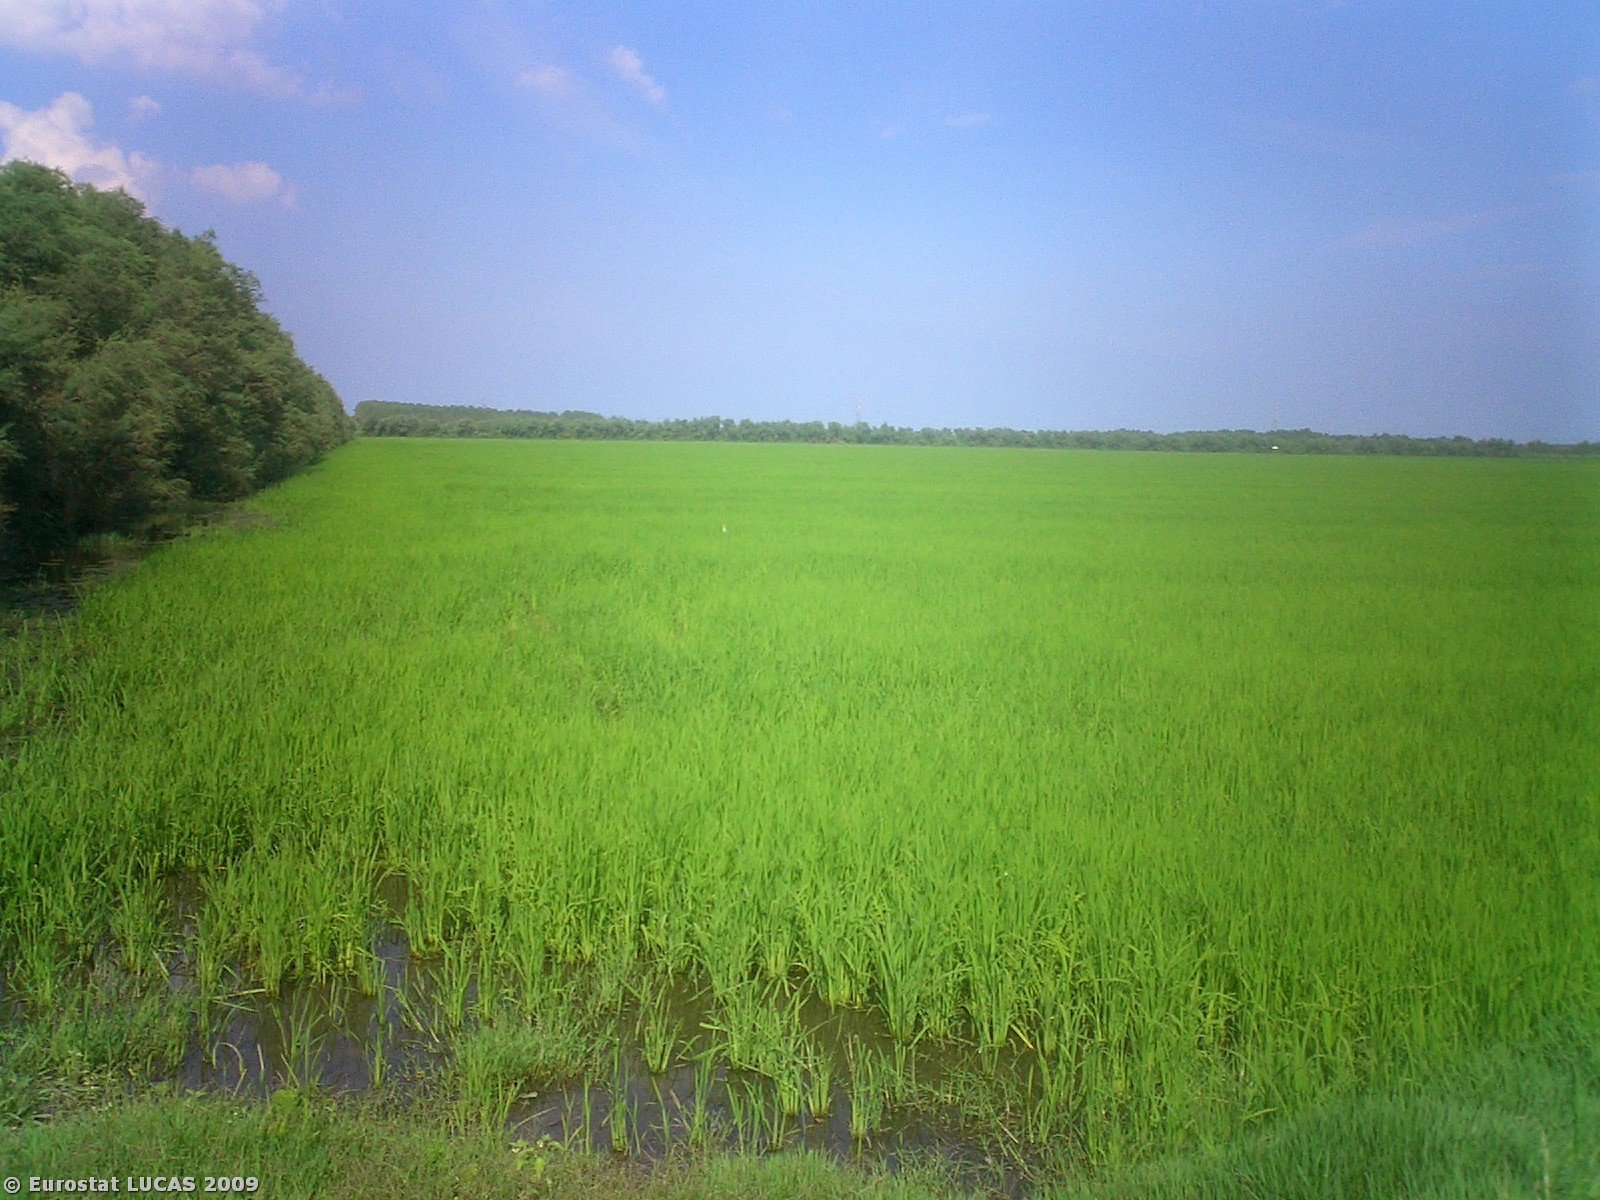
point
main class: Cropland
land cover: Rice
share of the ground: > 75 %
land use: Agriculture (excluding fallow land and kitchen gardens)
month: July
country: IT
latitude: 44.7451
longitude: 12.0547
